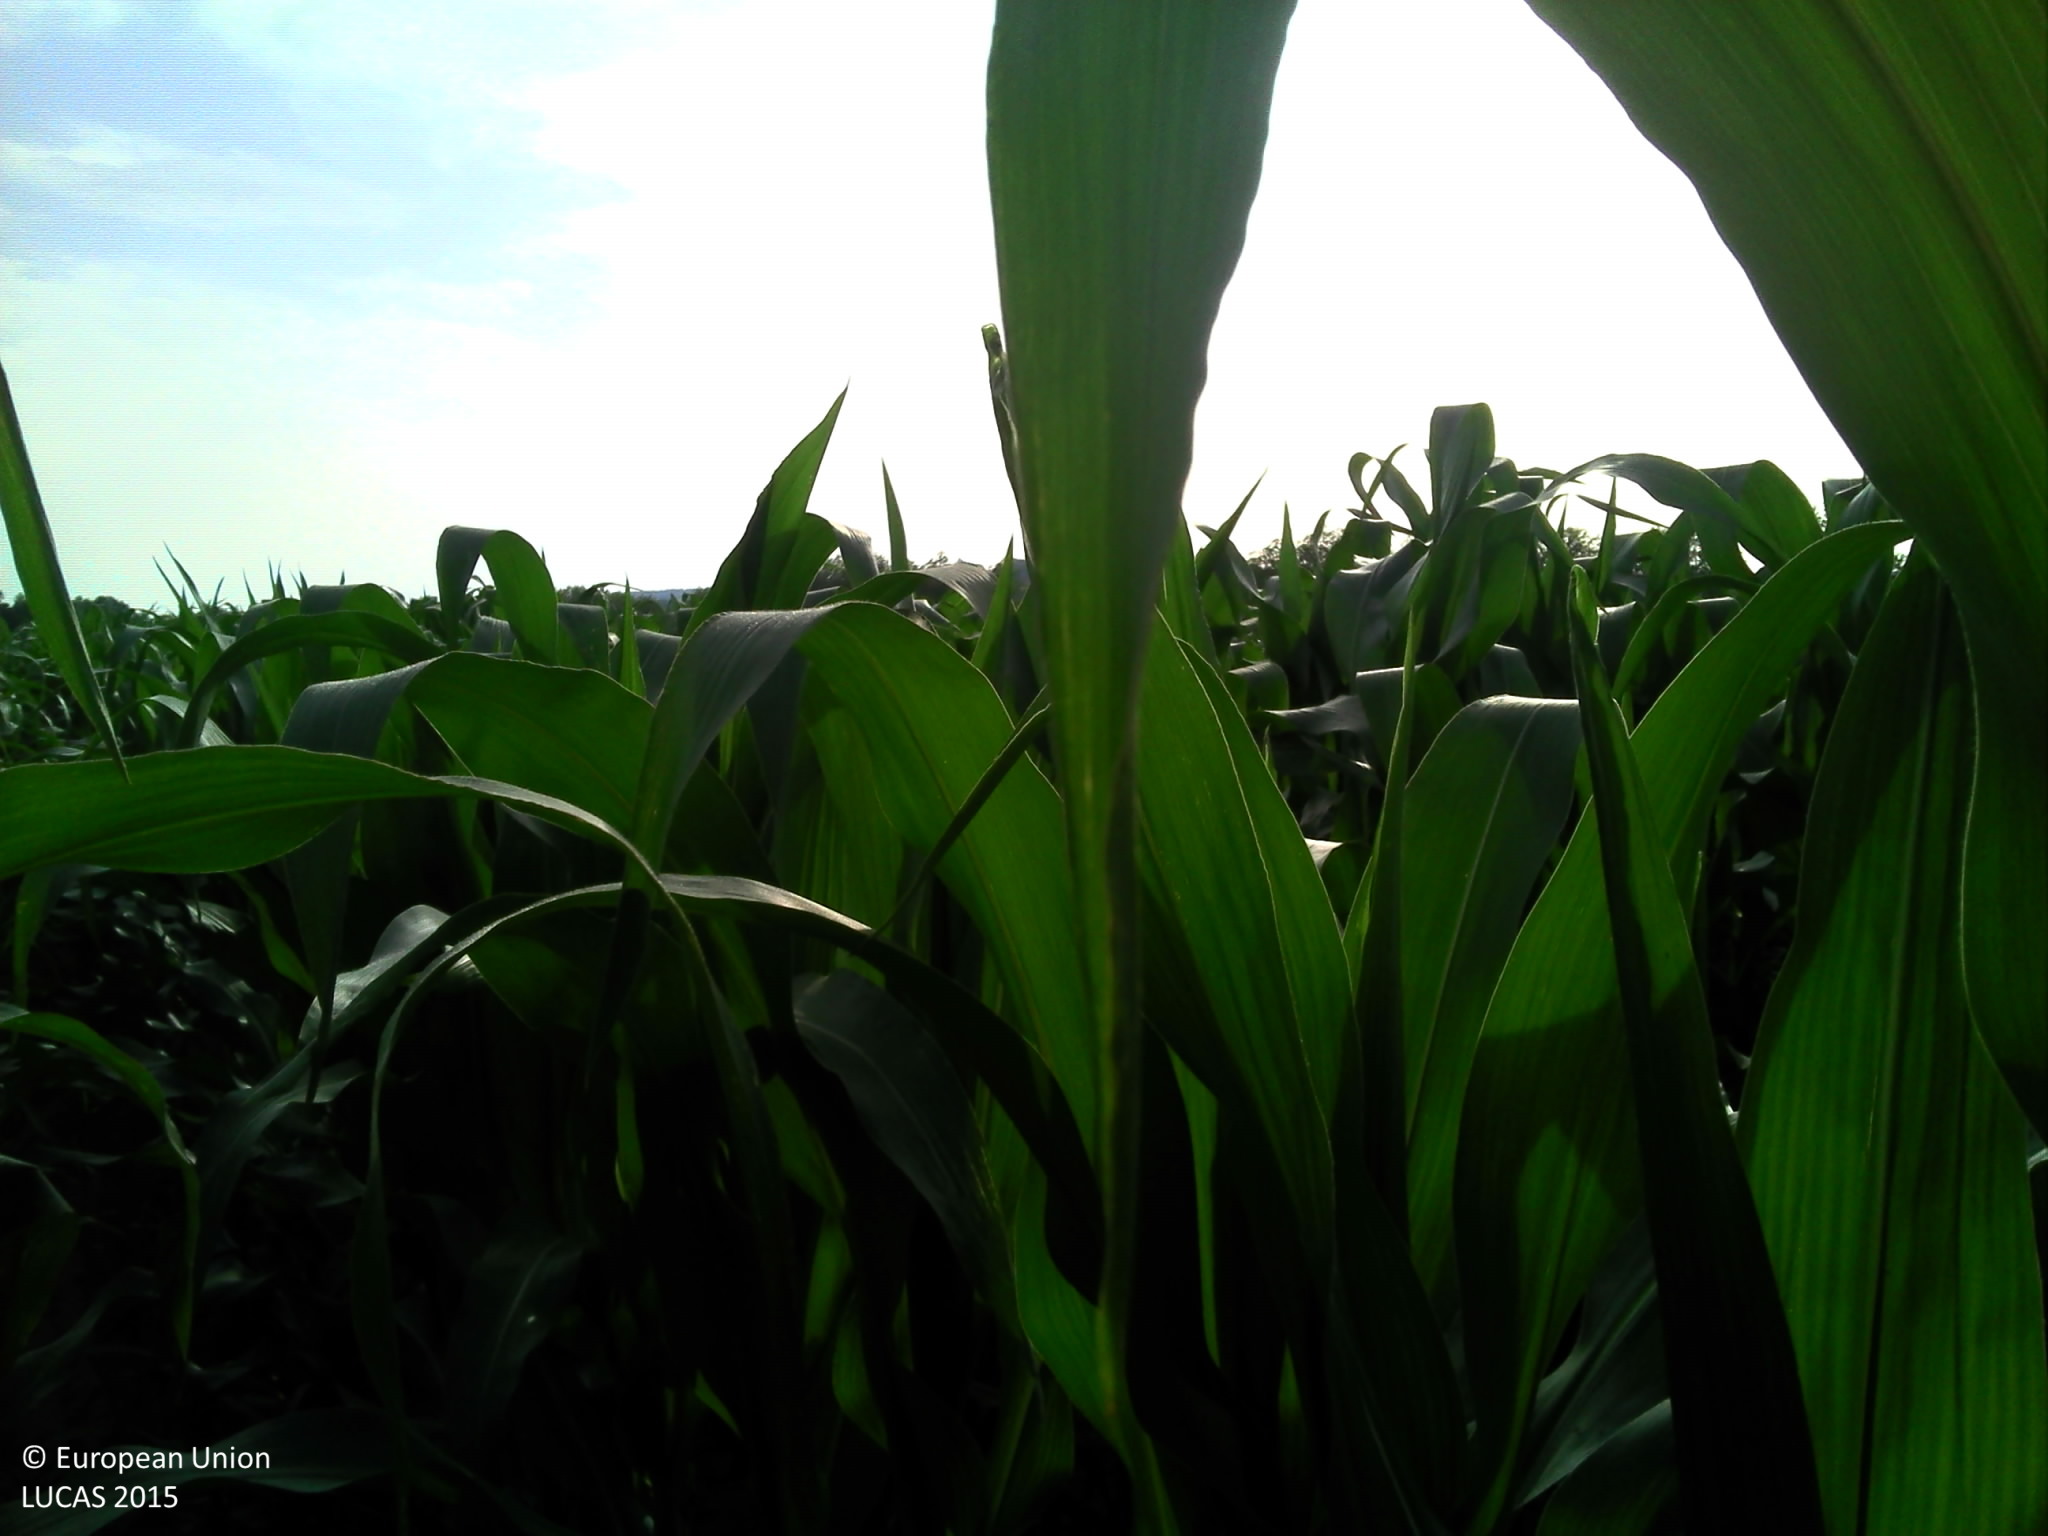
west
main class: Cropland
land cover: Maize
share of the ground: > 75 %
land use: Agriculture (excluding fallow land and kitchen gardens)
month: July
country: FR
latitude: 45.6713
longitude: 5.3188
